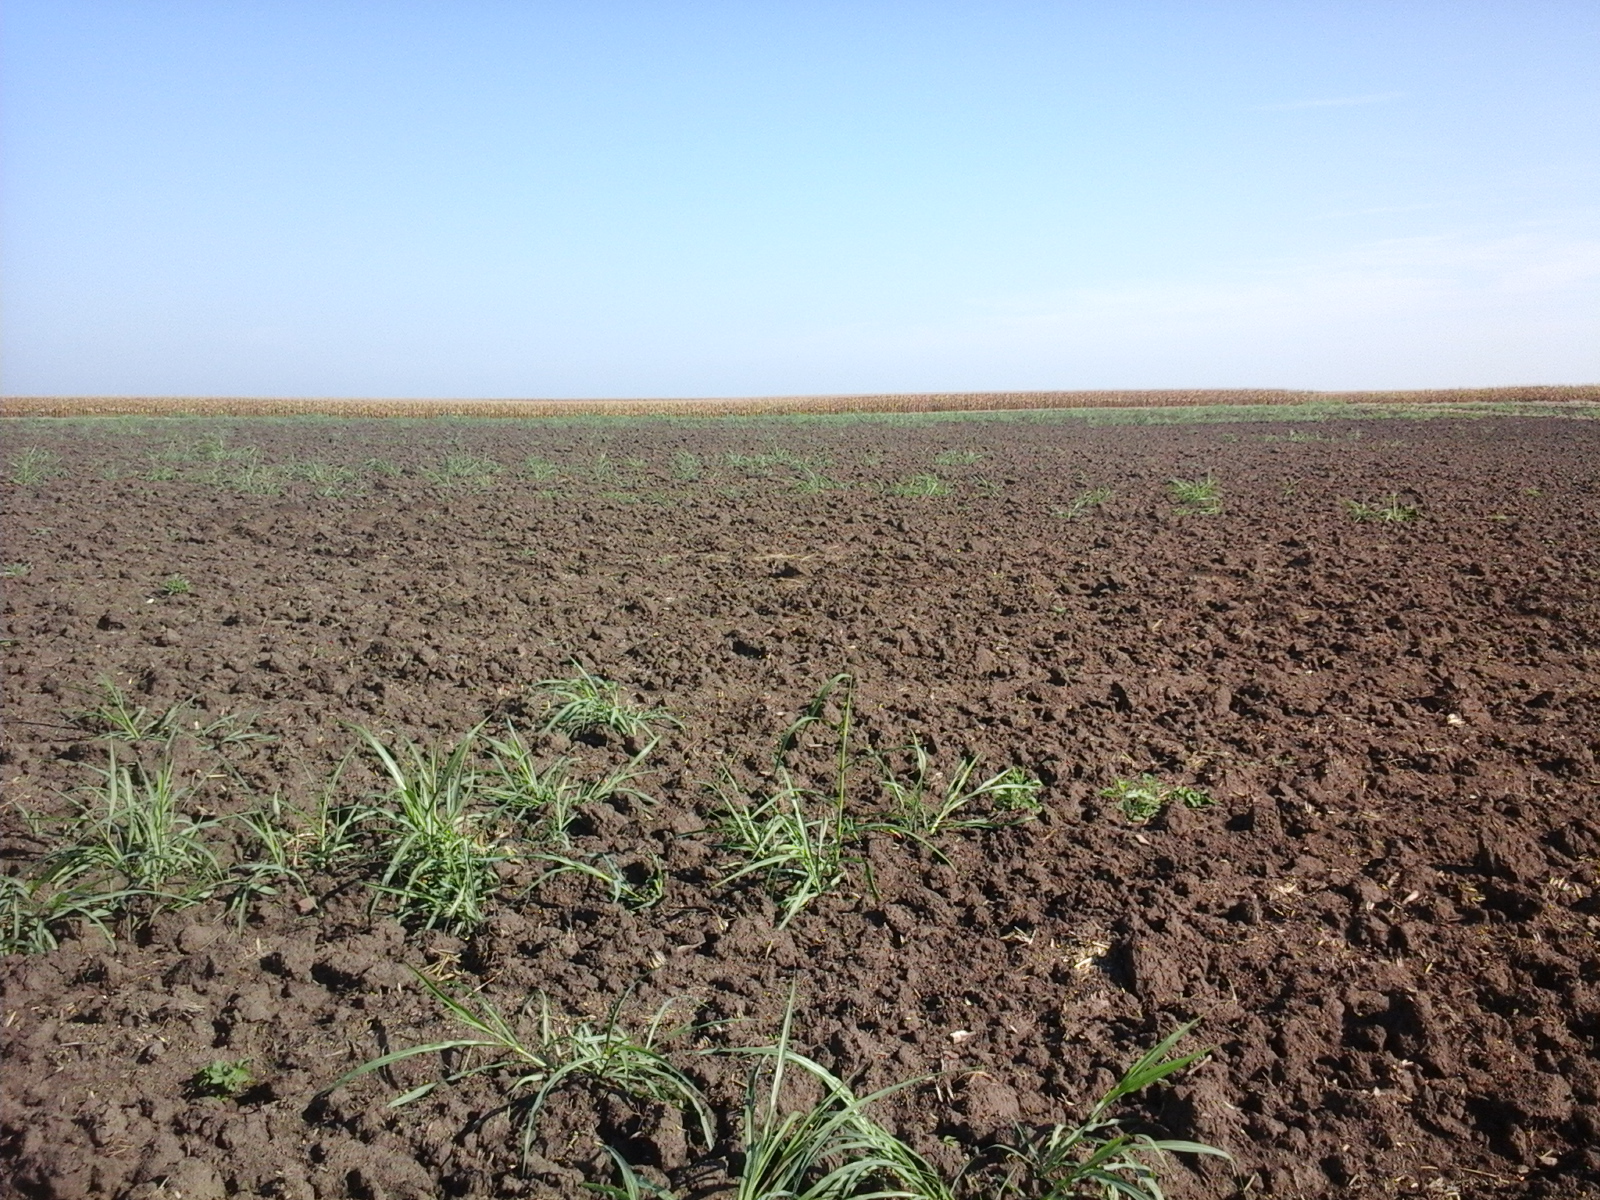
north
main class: Cropland
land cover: Common wheat
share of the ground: 10 - 25 %
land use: Agriculture (excluding fallow land and kitchen gardens)
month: August
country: RO
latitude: 46.0614
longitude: 21.1091
